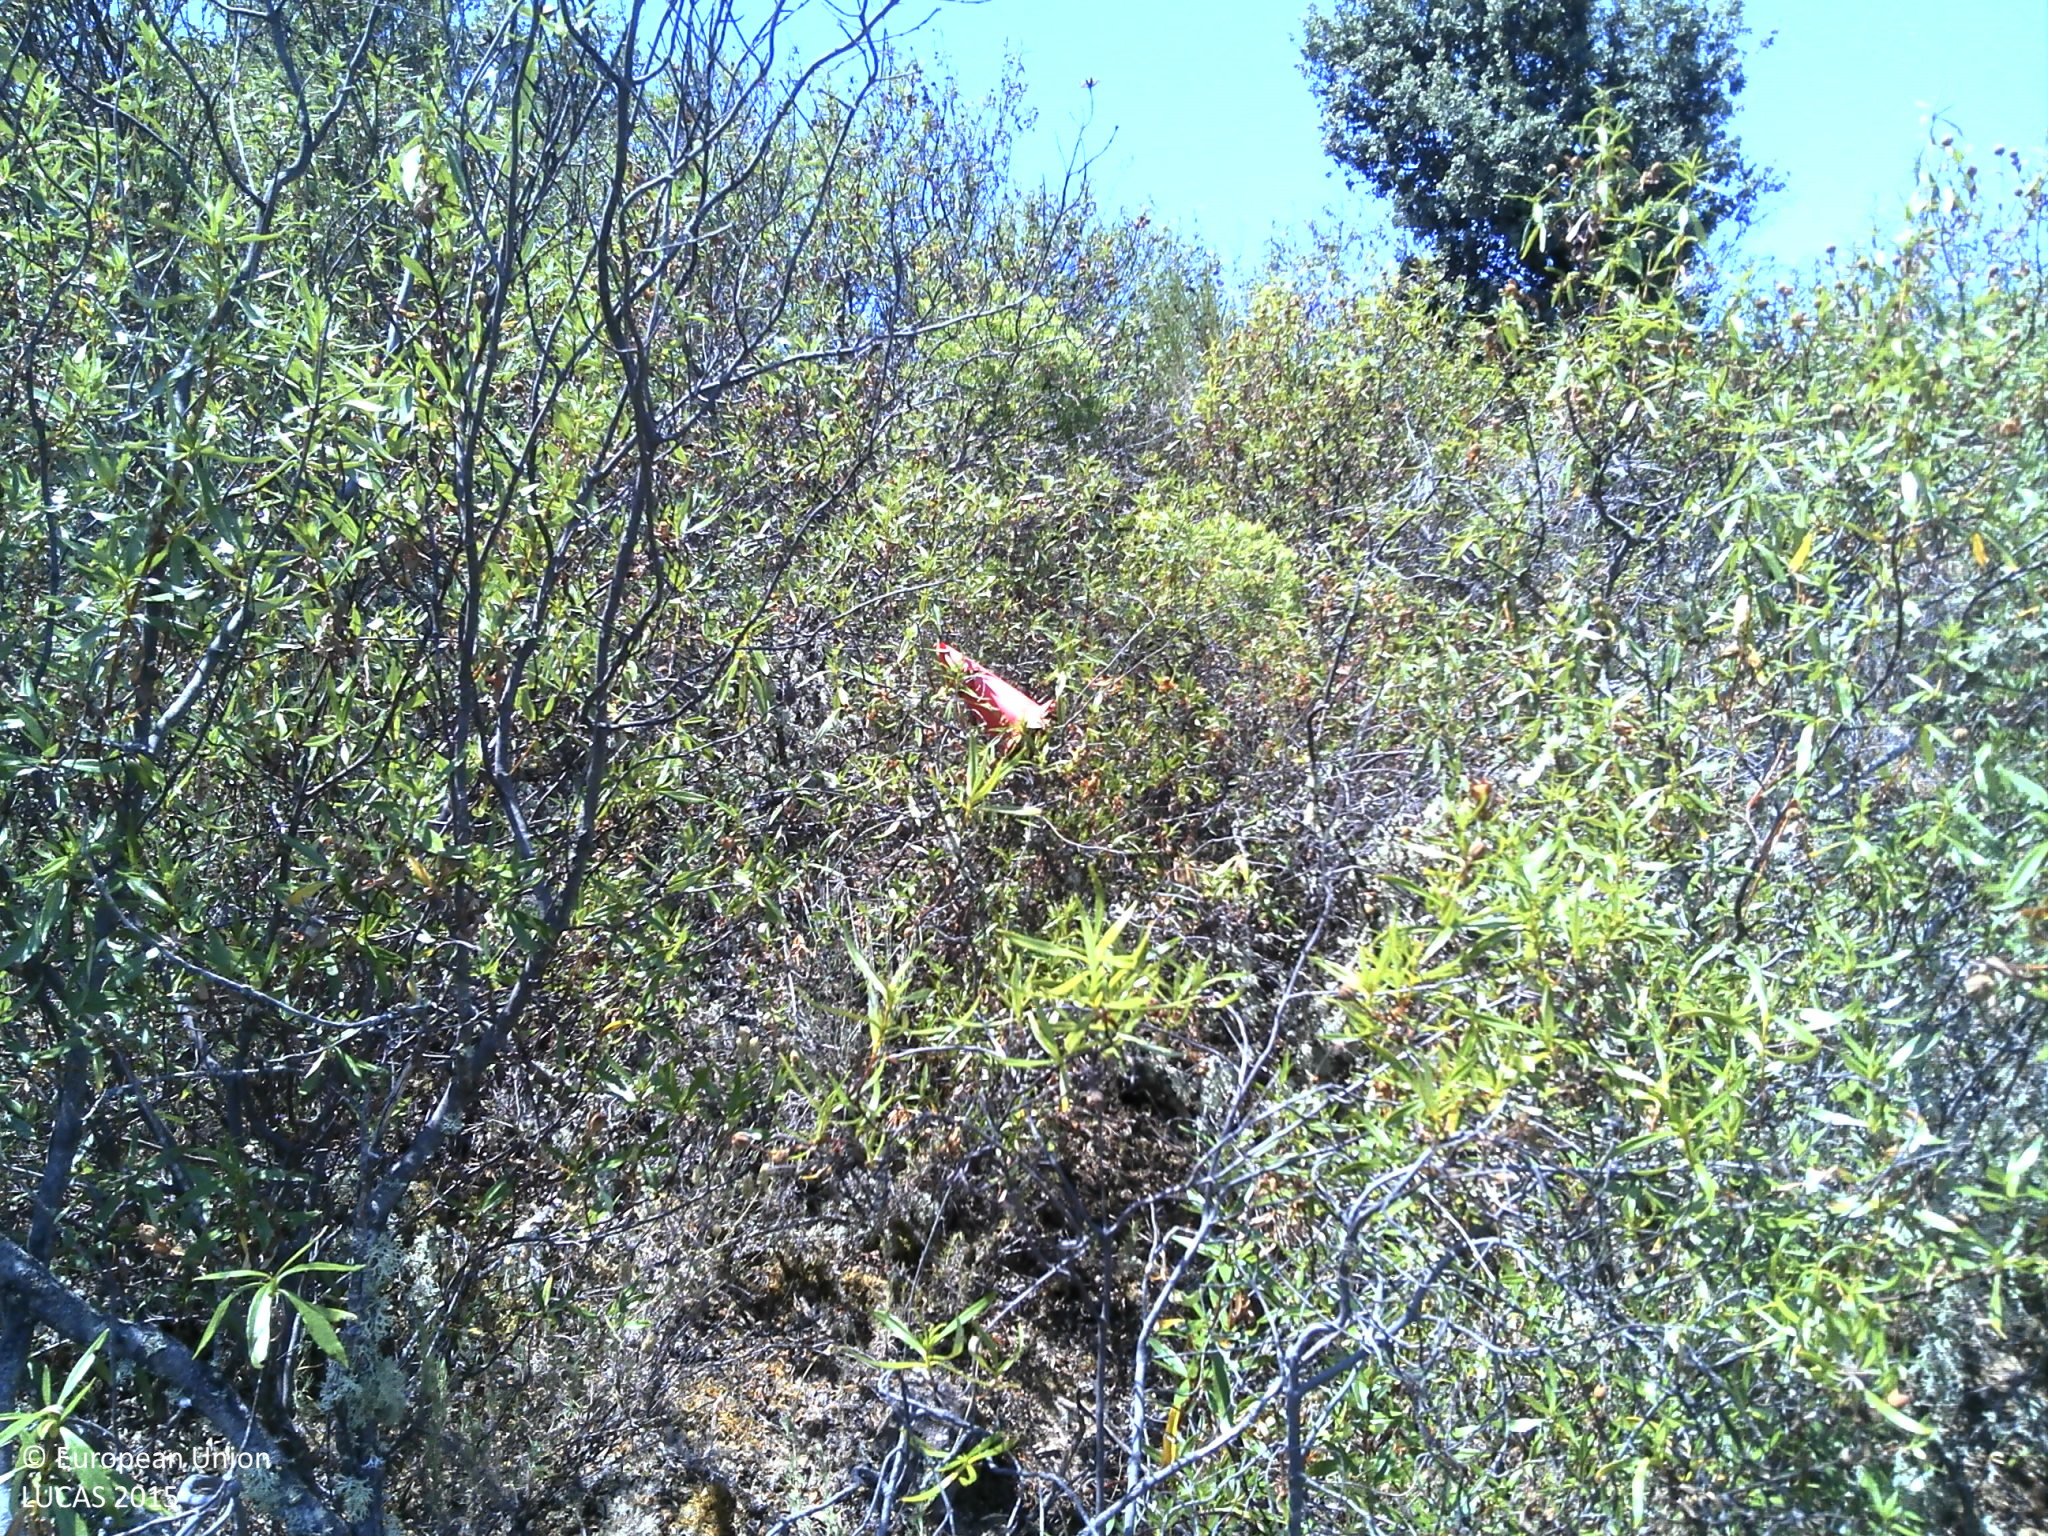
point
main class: Shrubland
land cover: Shrubland with sparse tree cover
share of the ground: > 75 %
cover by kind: shrubs 95 %, broadleaved forest trees 5 %
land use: Semi-natural and natural areas not in use
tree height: < 5 m
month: July
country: PT
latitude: 41.0178
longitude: -7.2247
